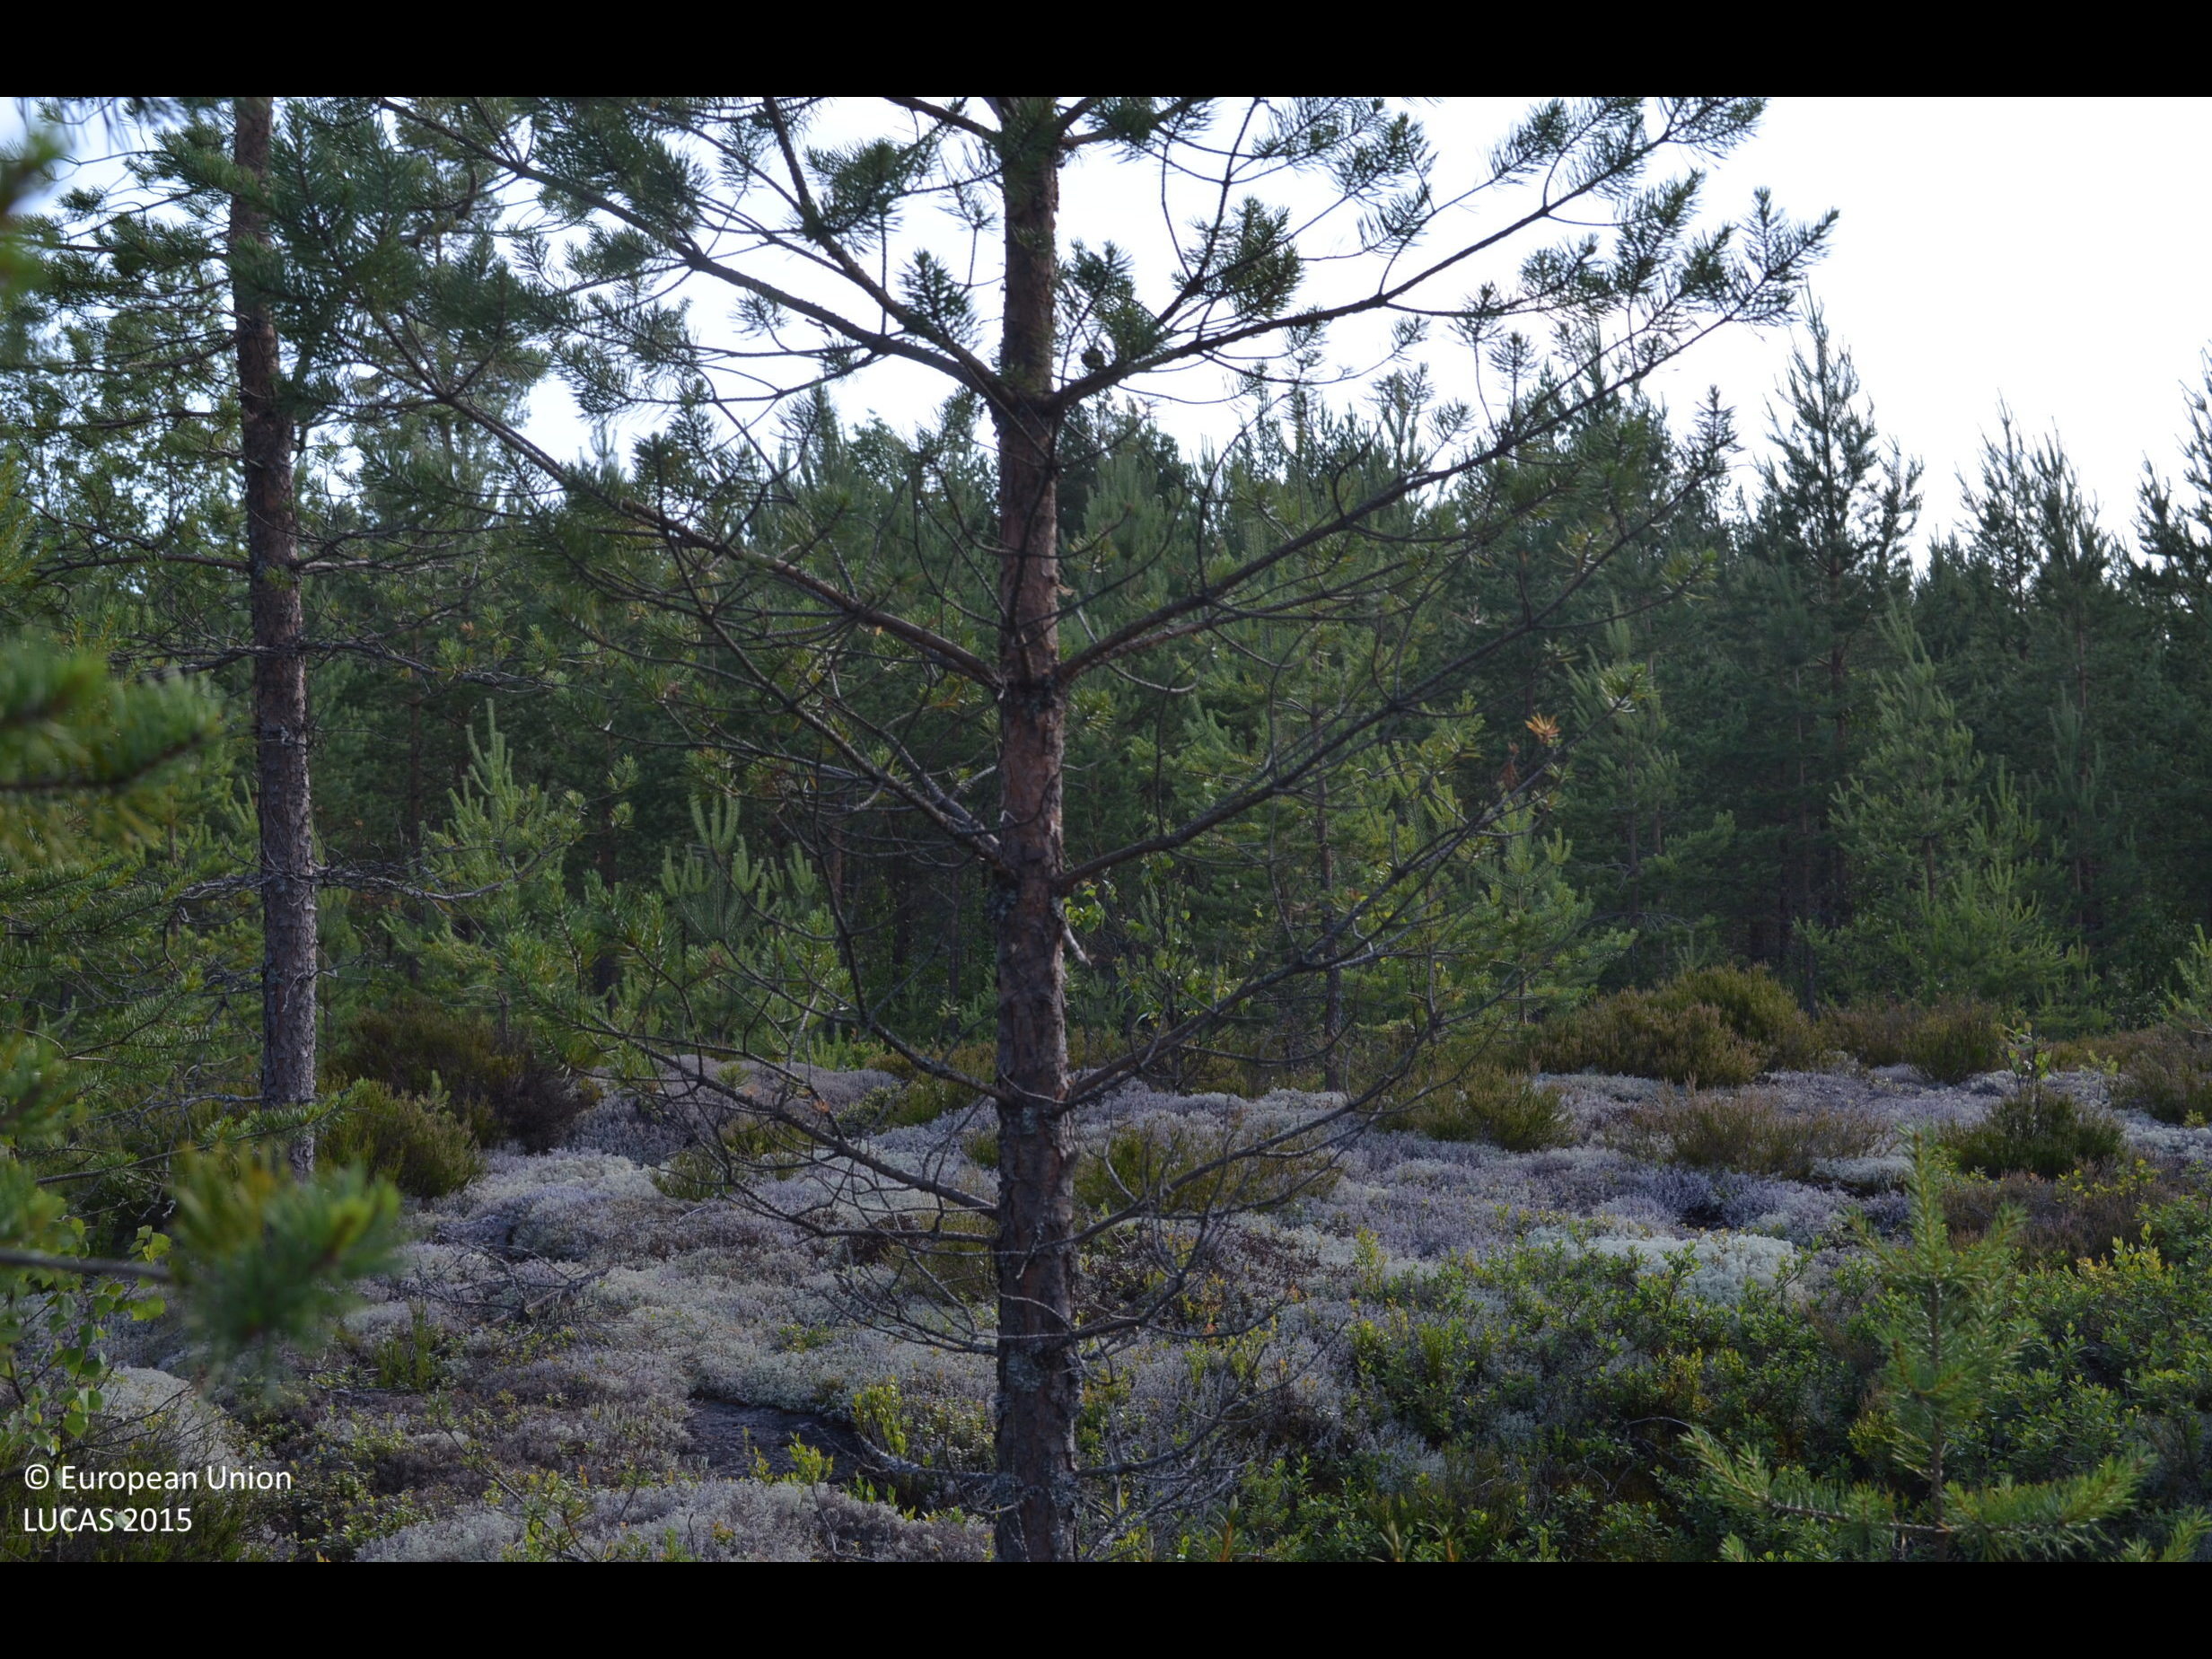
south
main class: Woodland
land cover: Pine dominated coniferous woodland
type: boreal forest
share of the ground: 50 - 75 %
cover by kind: coniferous forest trees 50 %, shrubs 35 %, lichens and mosses 15 %
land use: Forestry
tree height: < 5 m
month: July
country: FI
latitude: 62.3392
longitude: 23.6098
